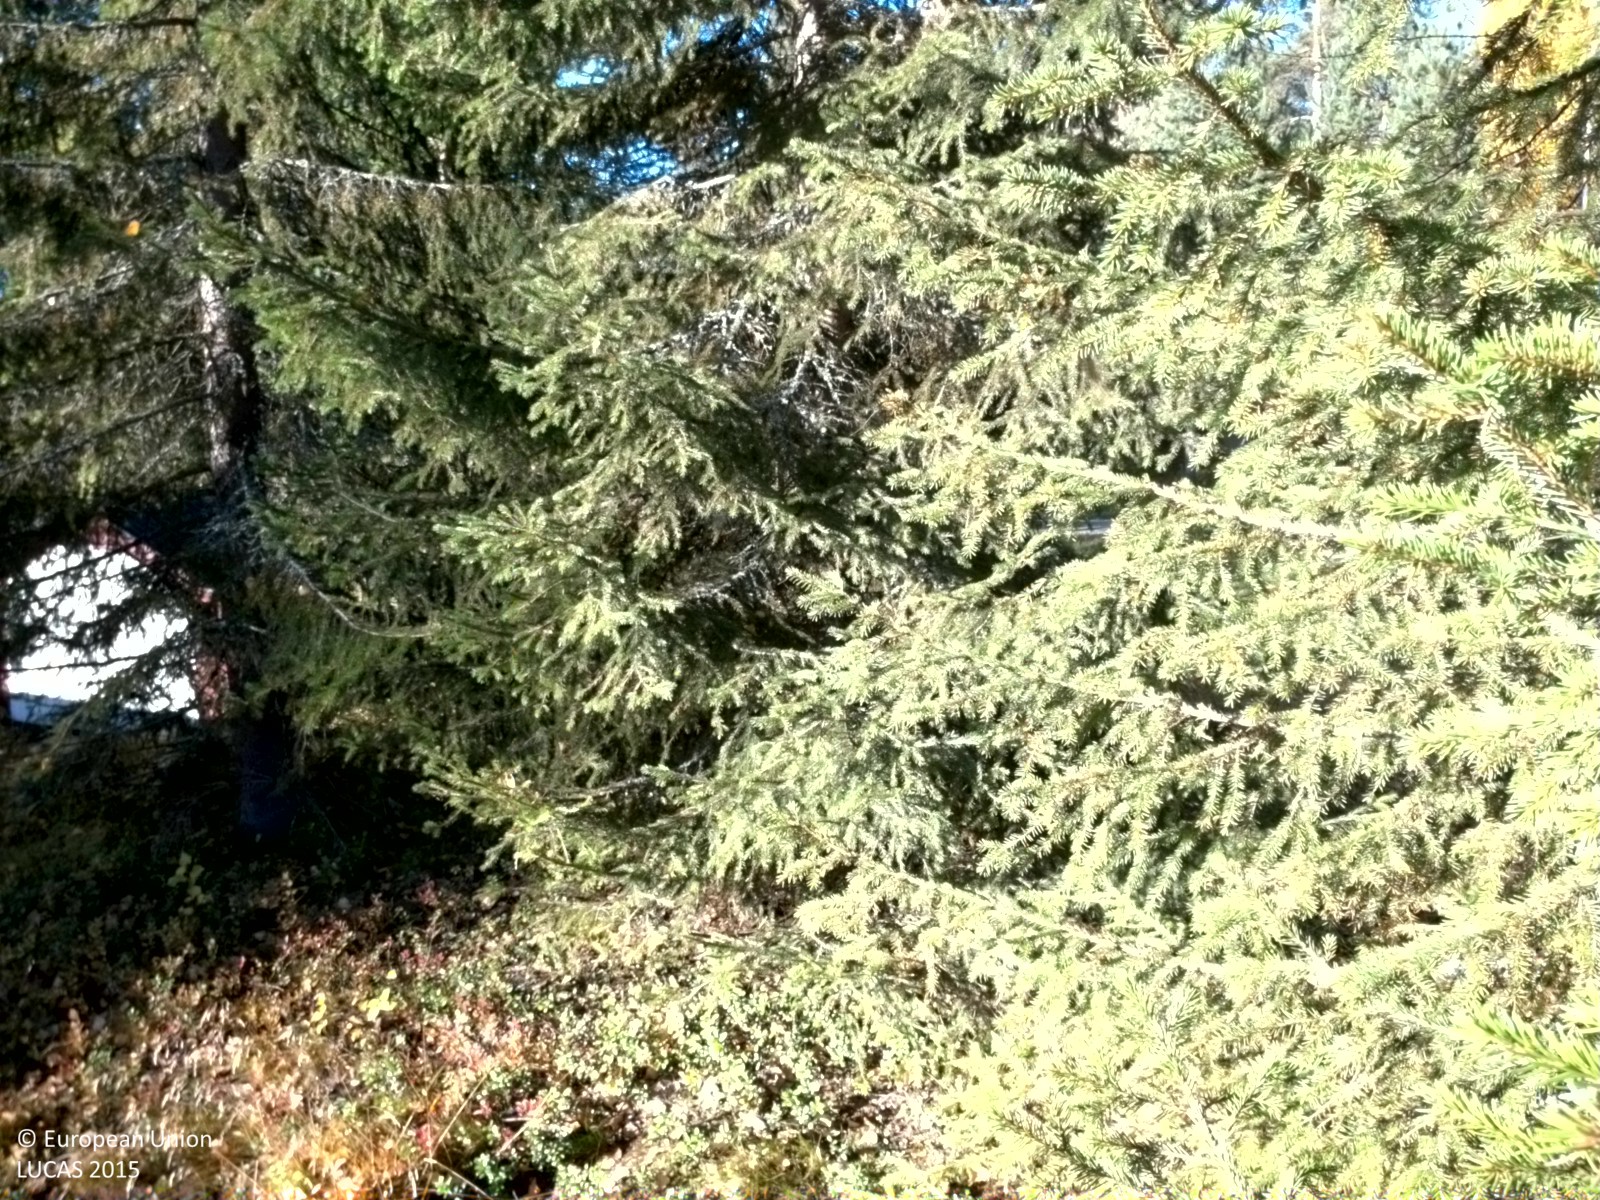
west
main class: Woodland
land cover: Spruce dominated mixed woodland
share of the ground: 50 - 75 %
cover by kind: coniferous forest trees 40 %, shrubs 30 %, broadleaved forest trees 20 %, herbaceous plants 10 %
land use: Residential
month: October
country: SE
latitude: 65.7620
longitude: 21.3876
